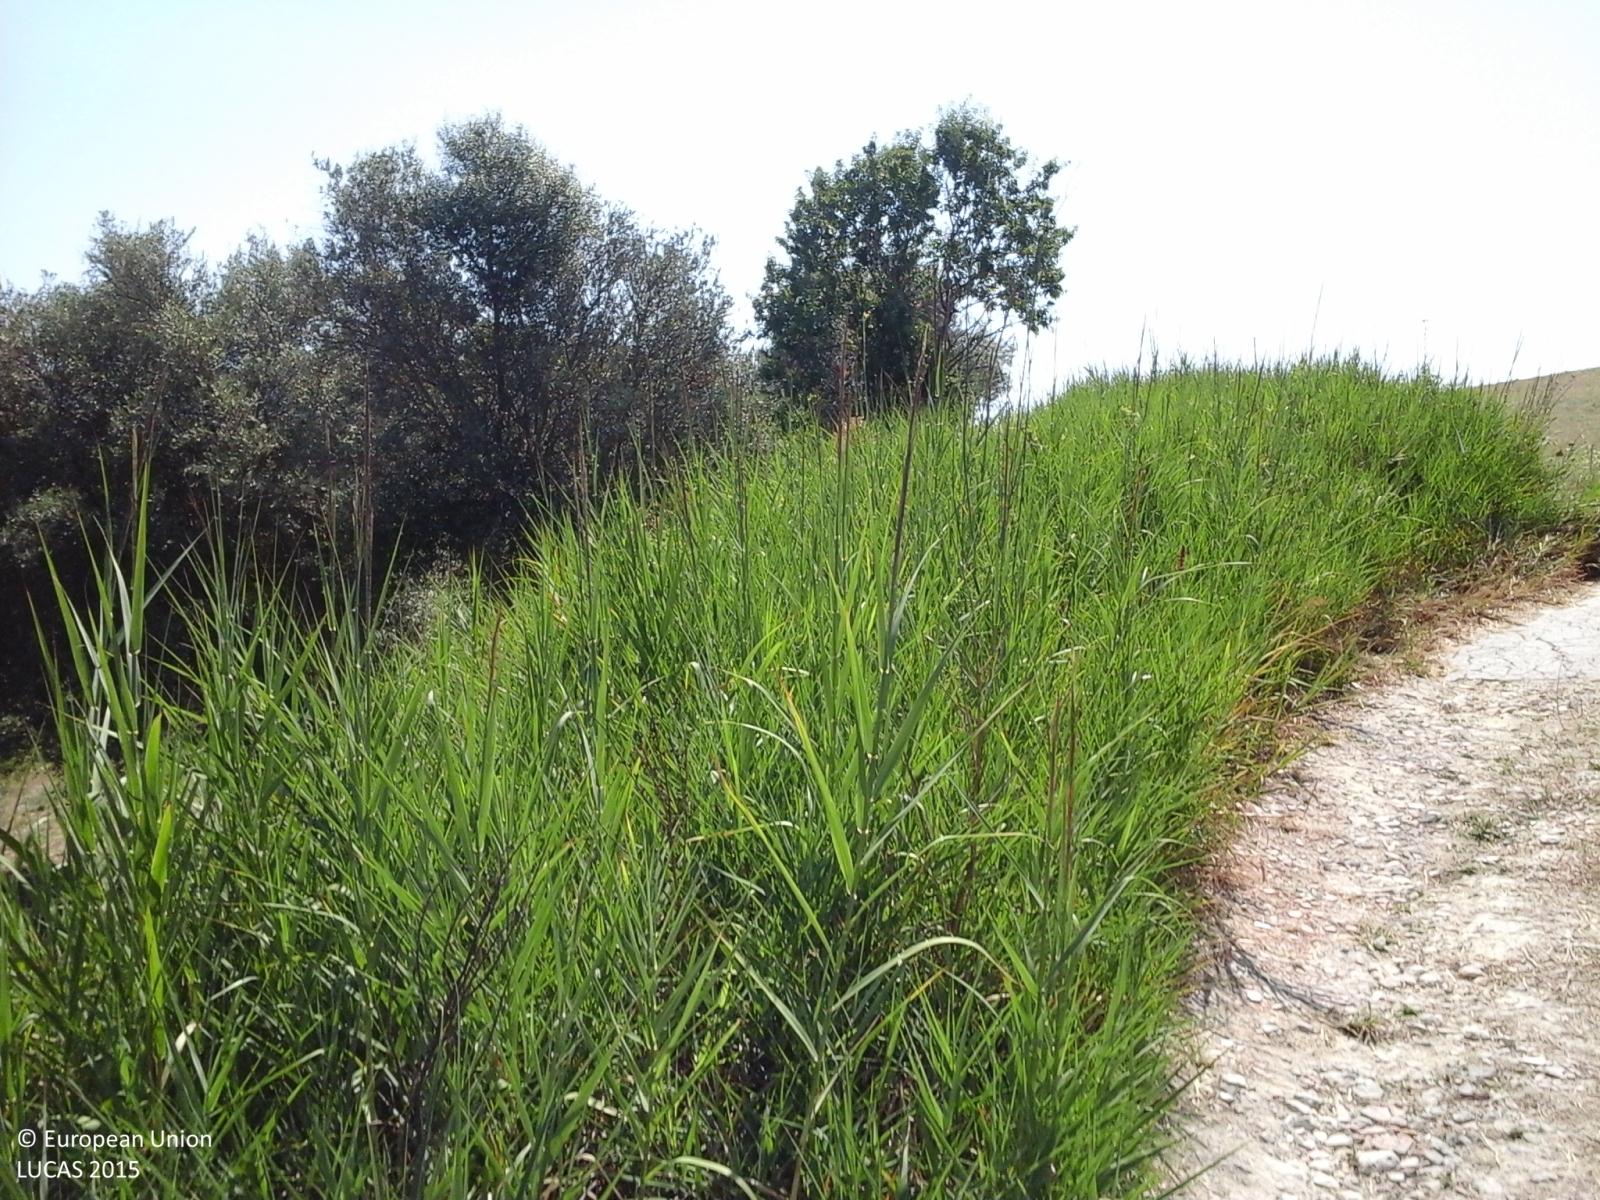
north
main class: Cropland
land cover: Mixed cereals for fodder
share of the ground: > 75 %
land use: Agriculture (excluding fallow land and kitchen gardens)
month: July
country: IT
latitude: 36.9860
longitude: 14.8716
